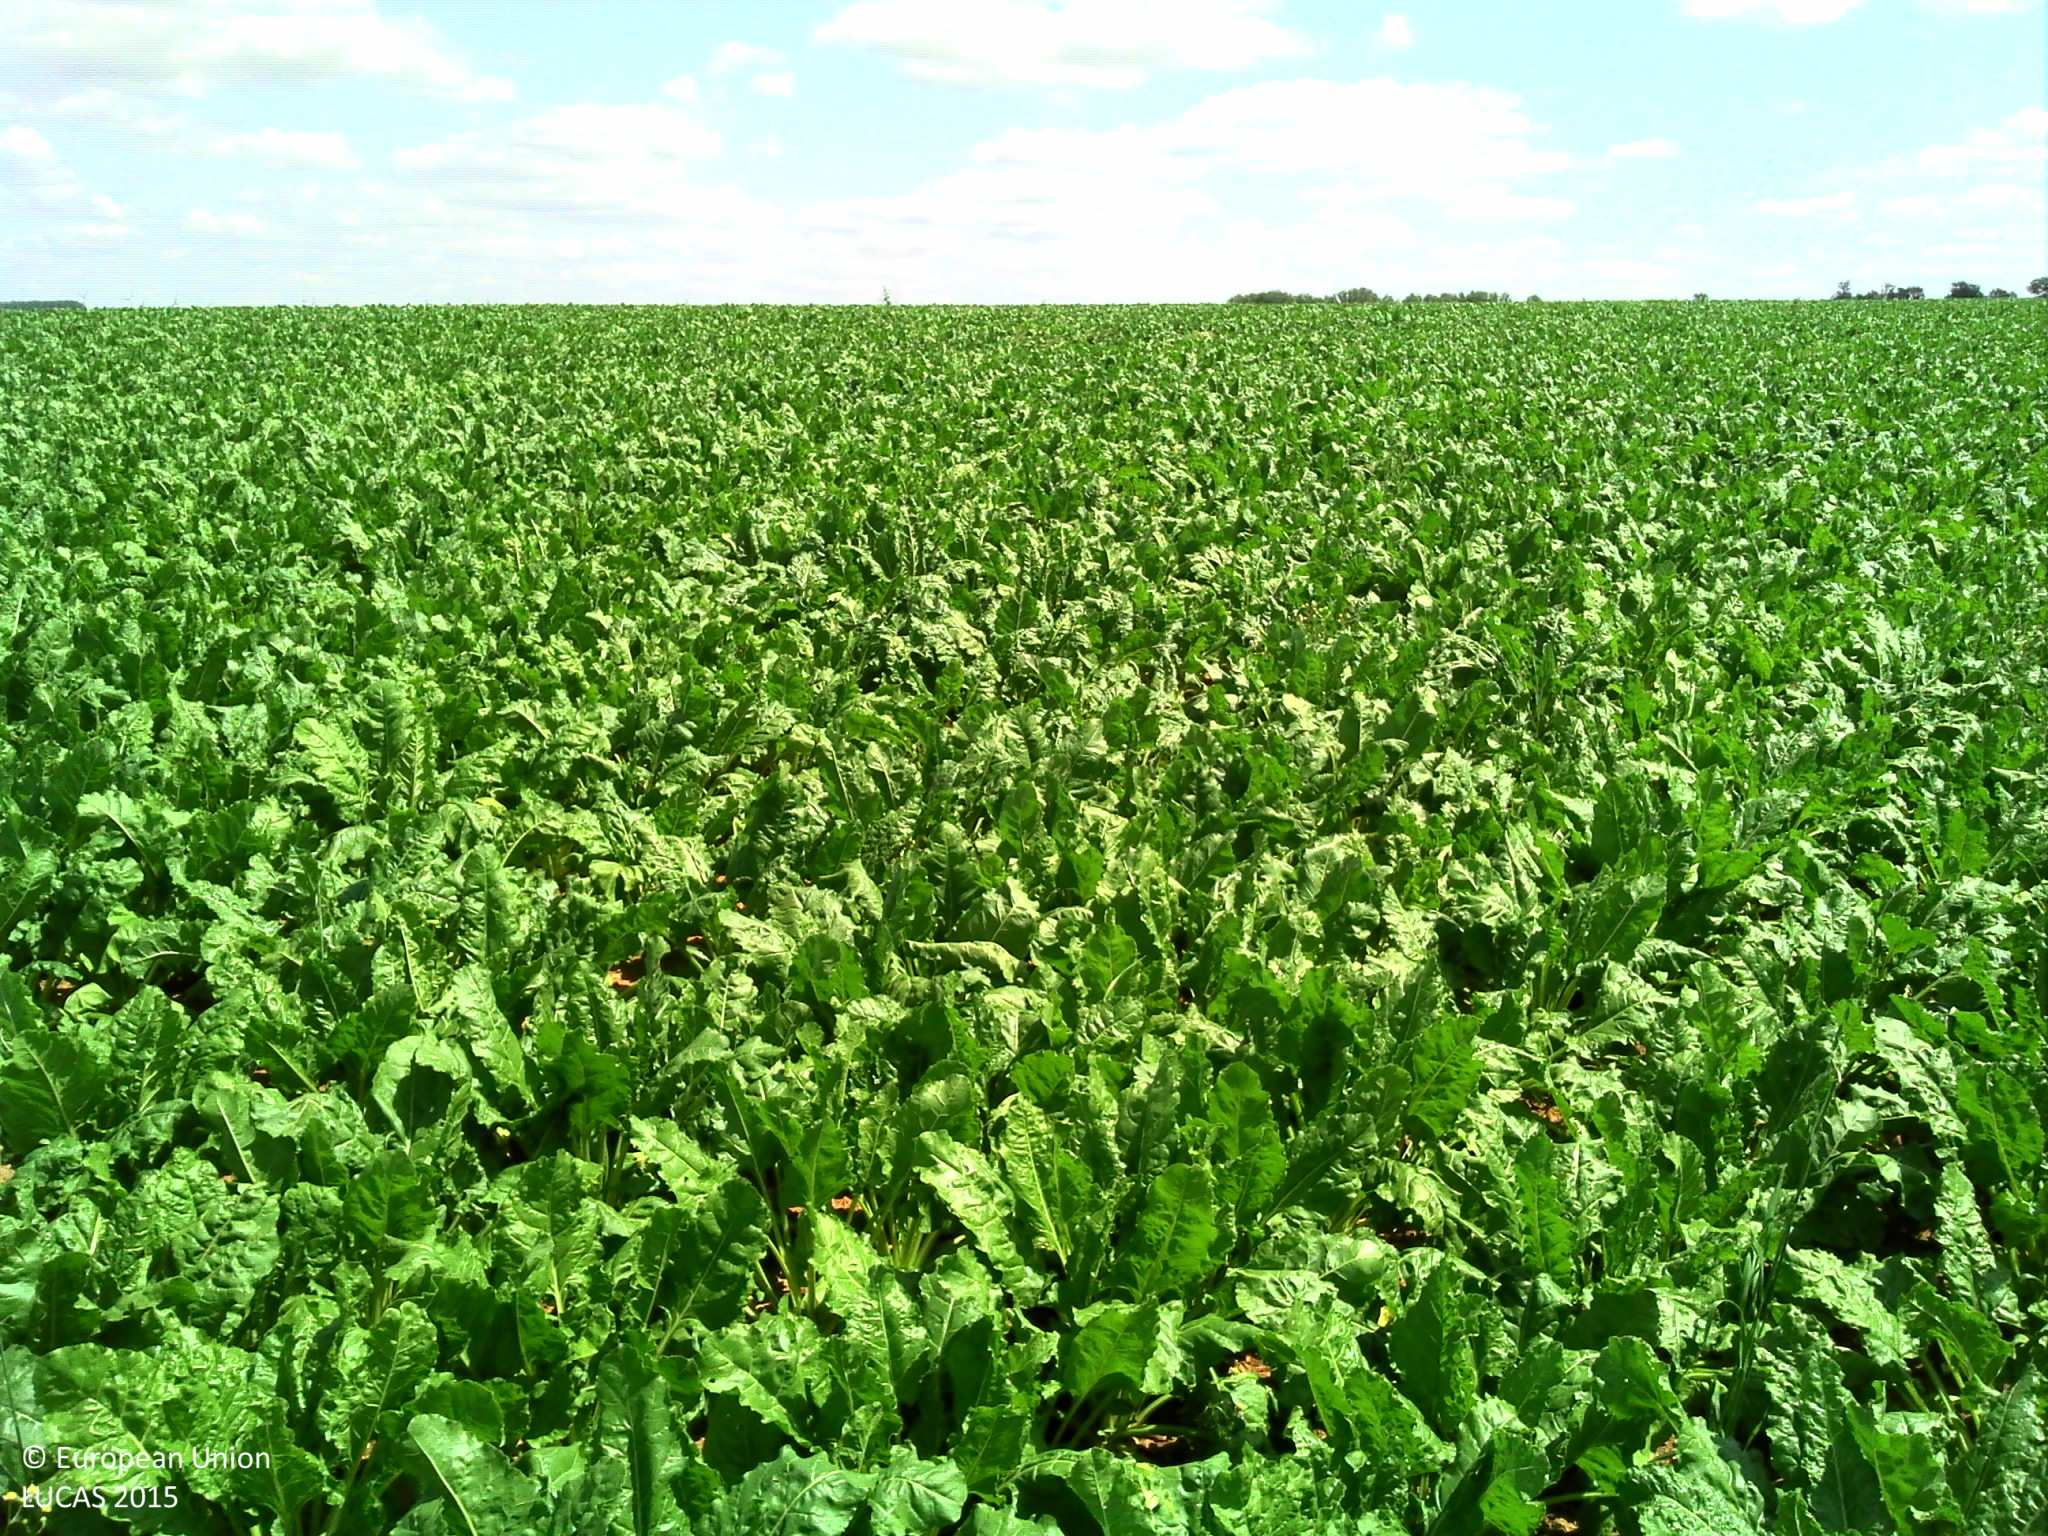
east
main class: Cropland
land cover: Sugar beet
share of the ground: > 75 %
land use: Agriculture (excluding fallow land and kitchen gardens)
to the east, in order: Grass margins; Sugar beet; Grass margins; Paved roads, cycling and walking lanes; Grass margins; Sugar beet
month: July
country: FR
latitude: 50.3494
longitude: 2.1858
